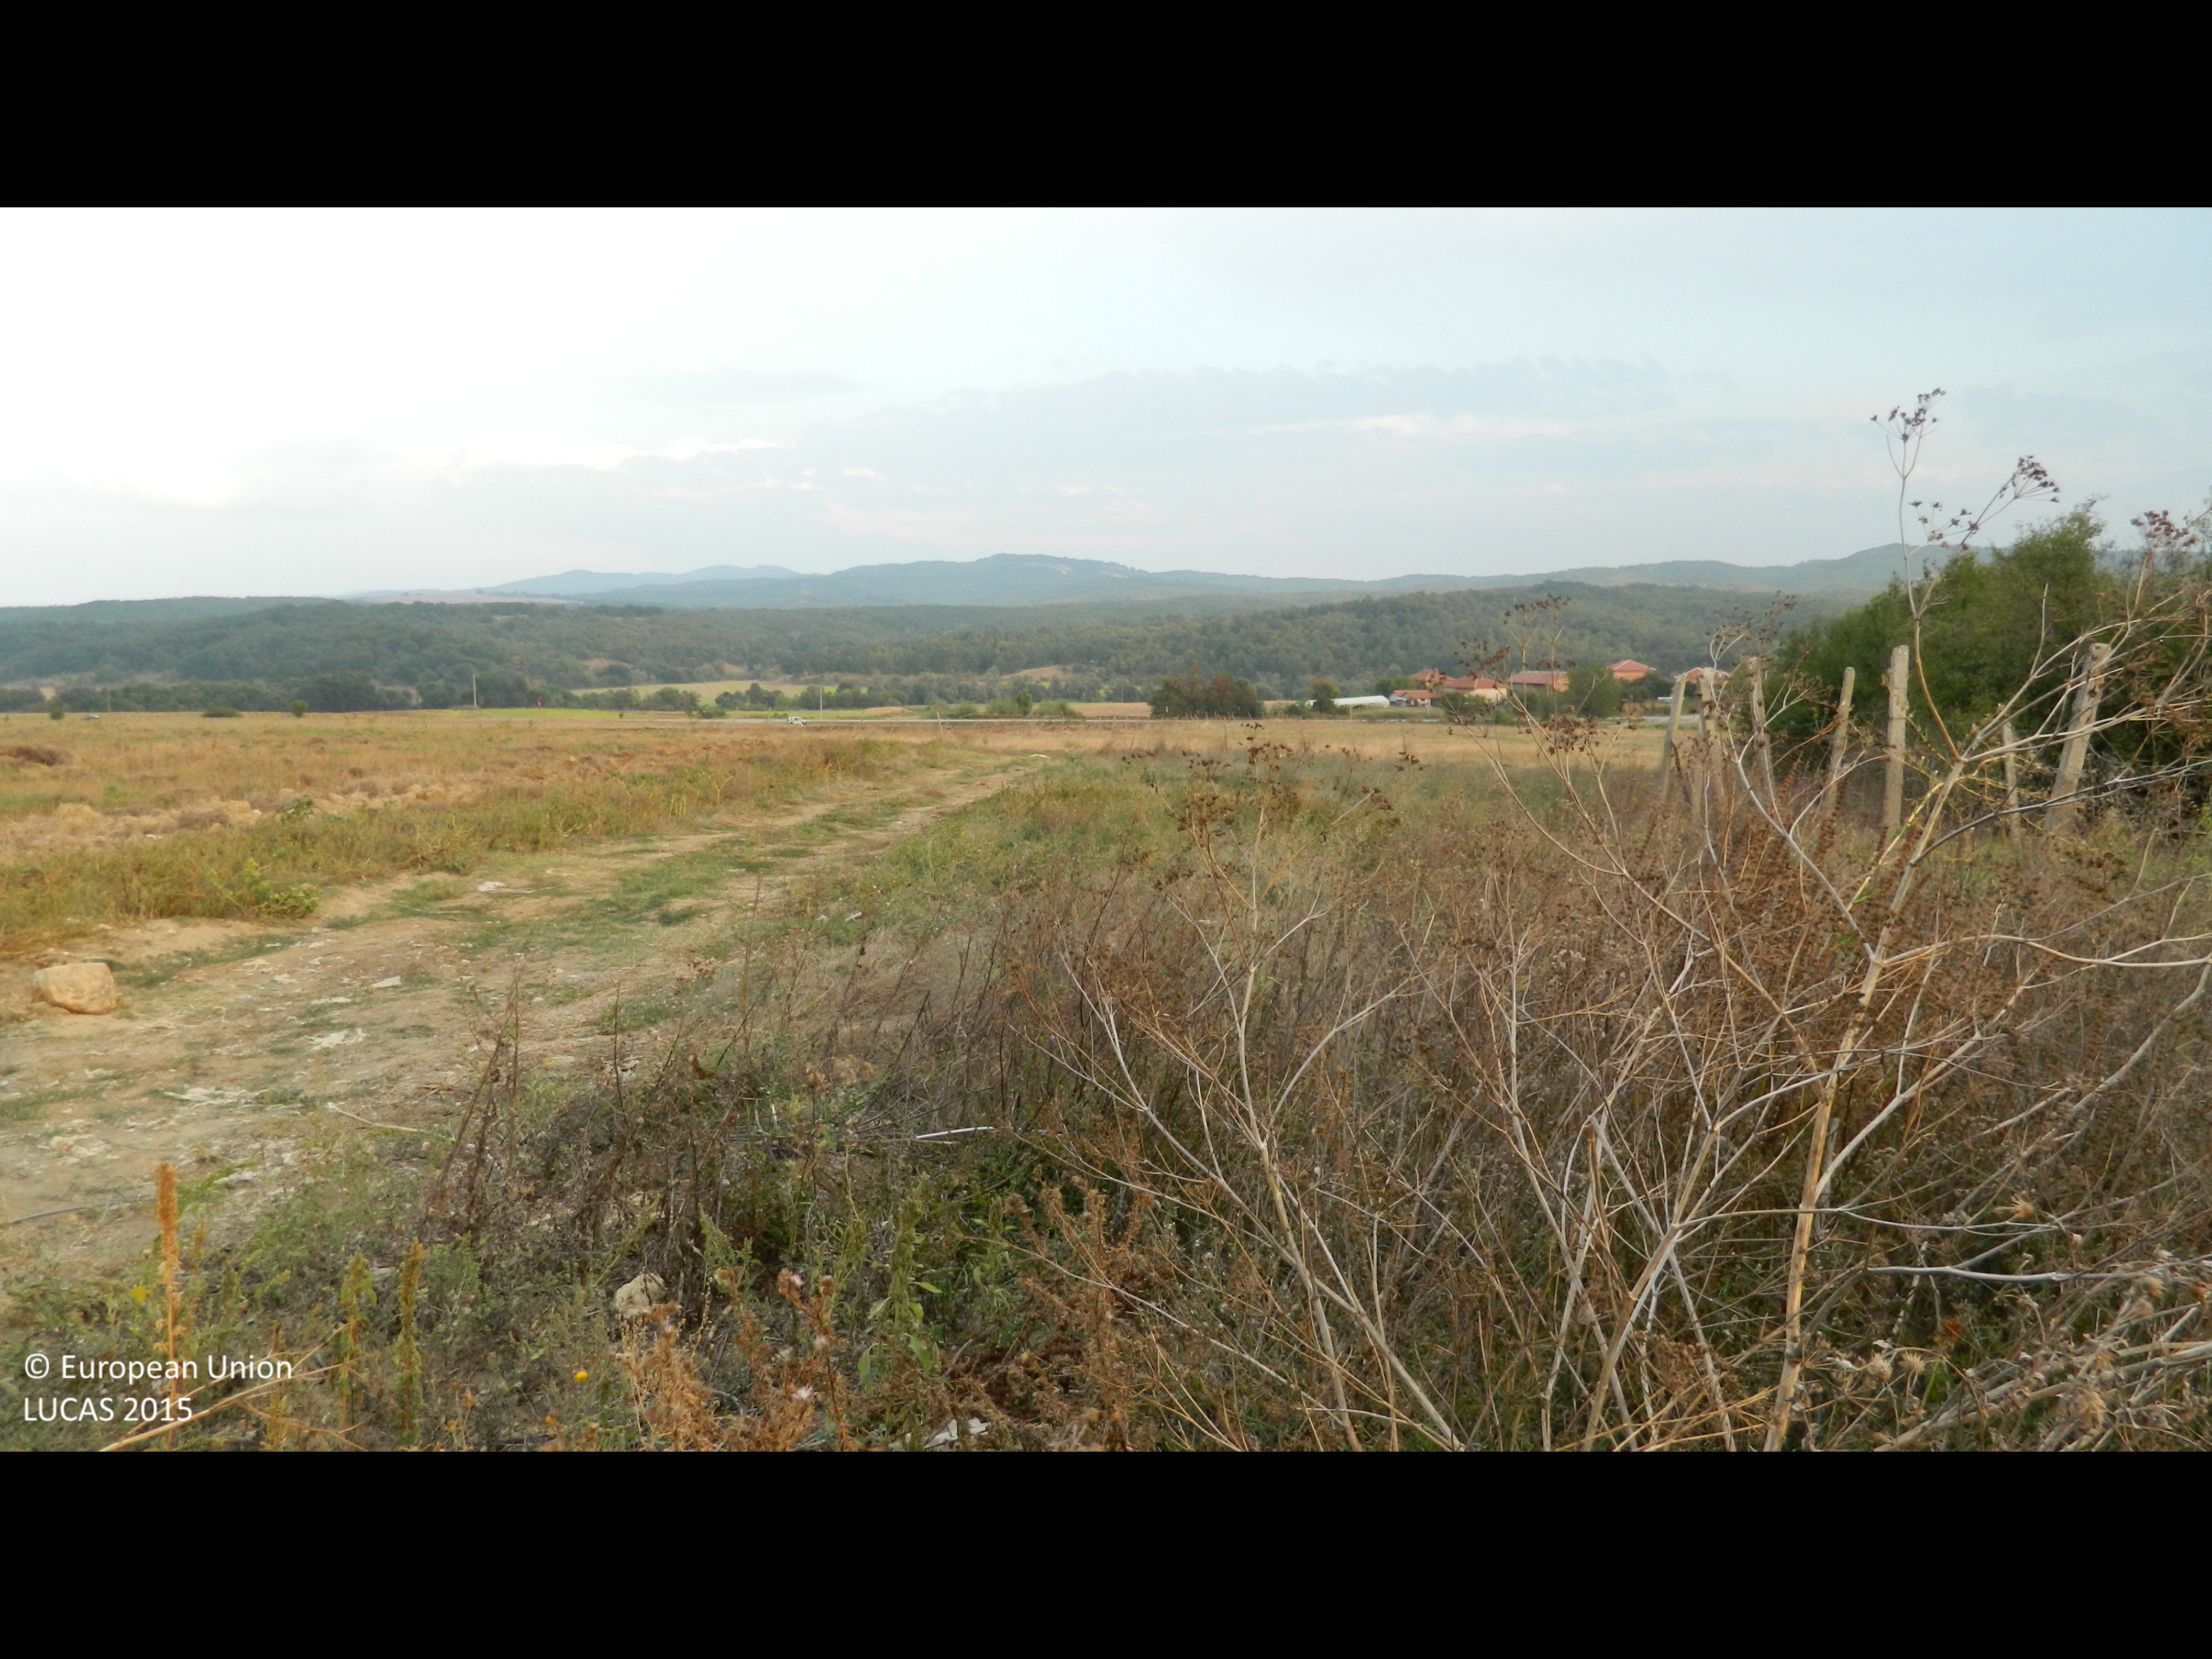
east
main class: Cropland
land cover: Maize
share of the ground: > 75 %
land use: Kitchen garden
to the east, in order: Maize; Other fresh vegetables; Fences; Grassland without tree/shrub cover; Tracks; Spontaneously vegetated surfaces; Common wheat
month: September
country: BG
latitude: 41.7497
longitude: 25.7106
